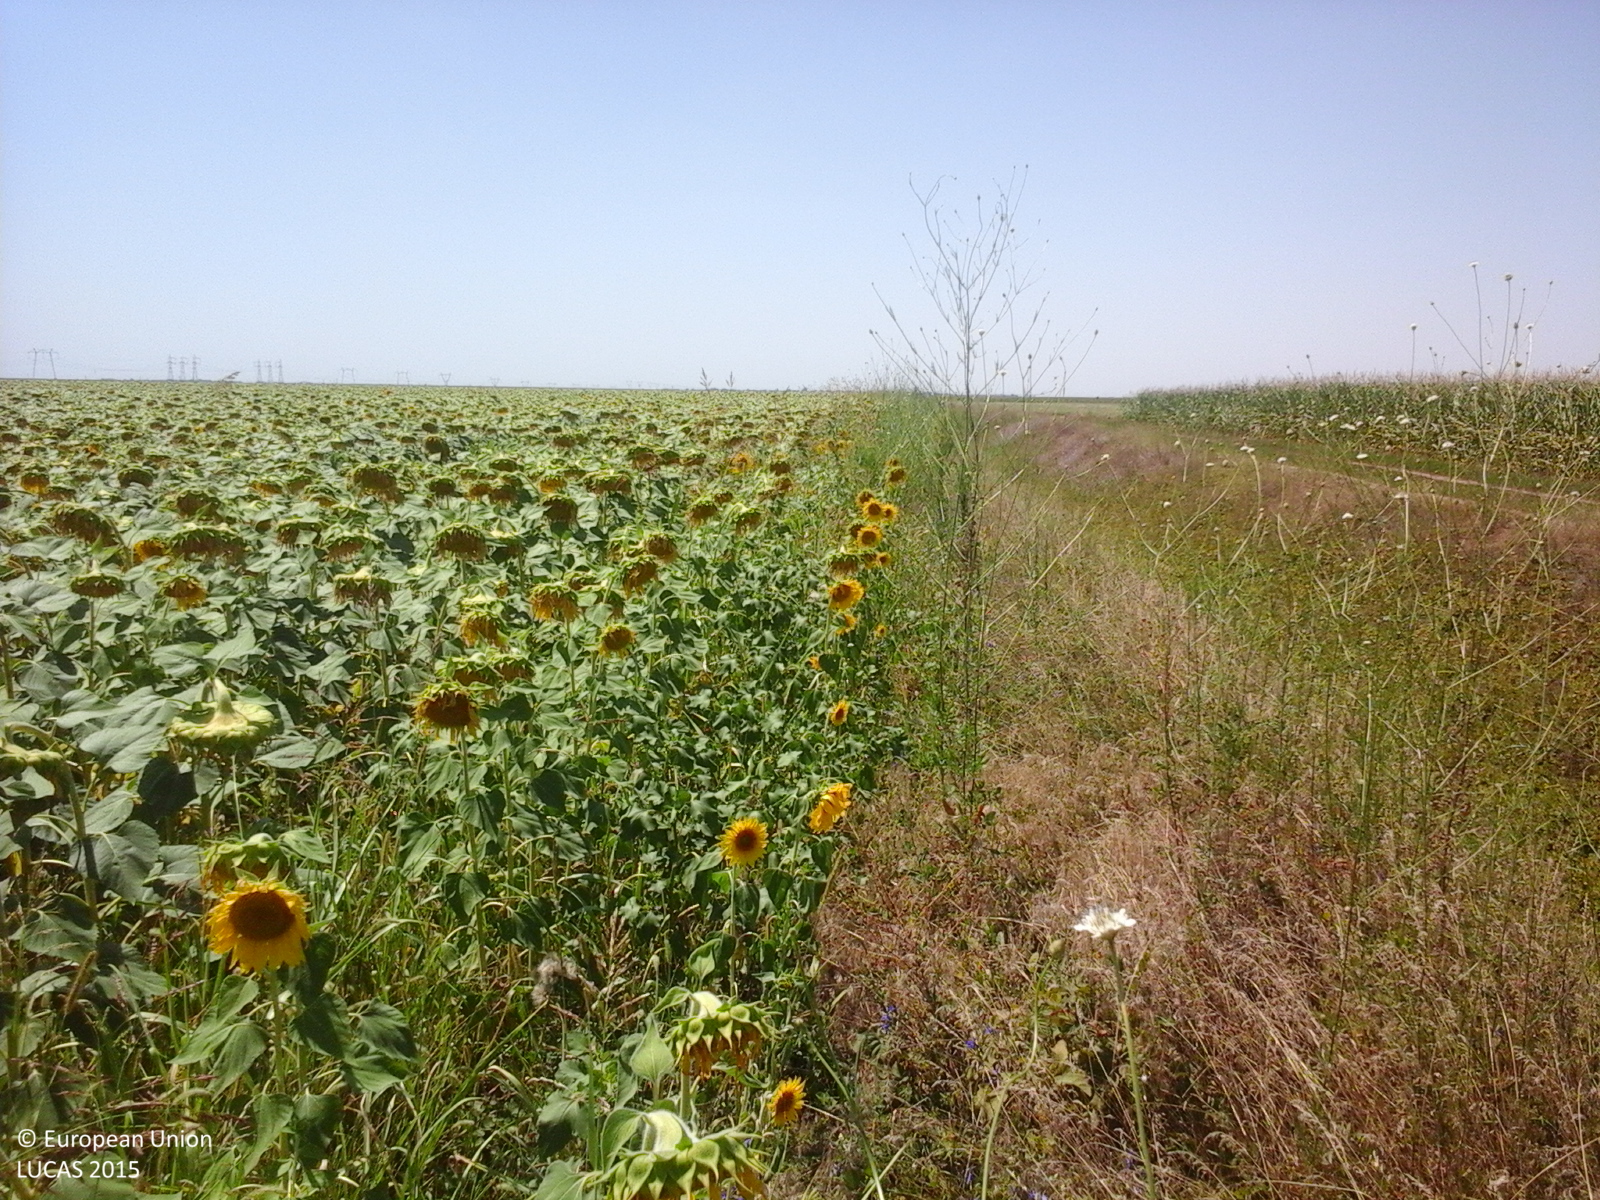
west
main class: Cropland
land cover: Sunflower
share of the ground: > 75 %
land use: Agriculture (excluding fallow land and kitchen gardens)
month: July
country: RO
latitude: 44.2530
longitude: 26.4817
